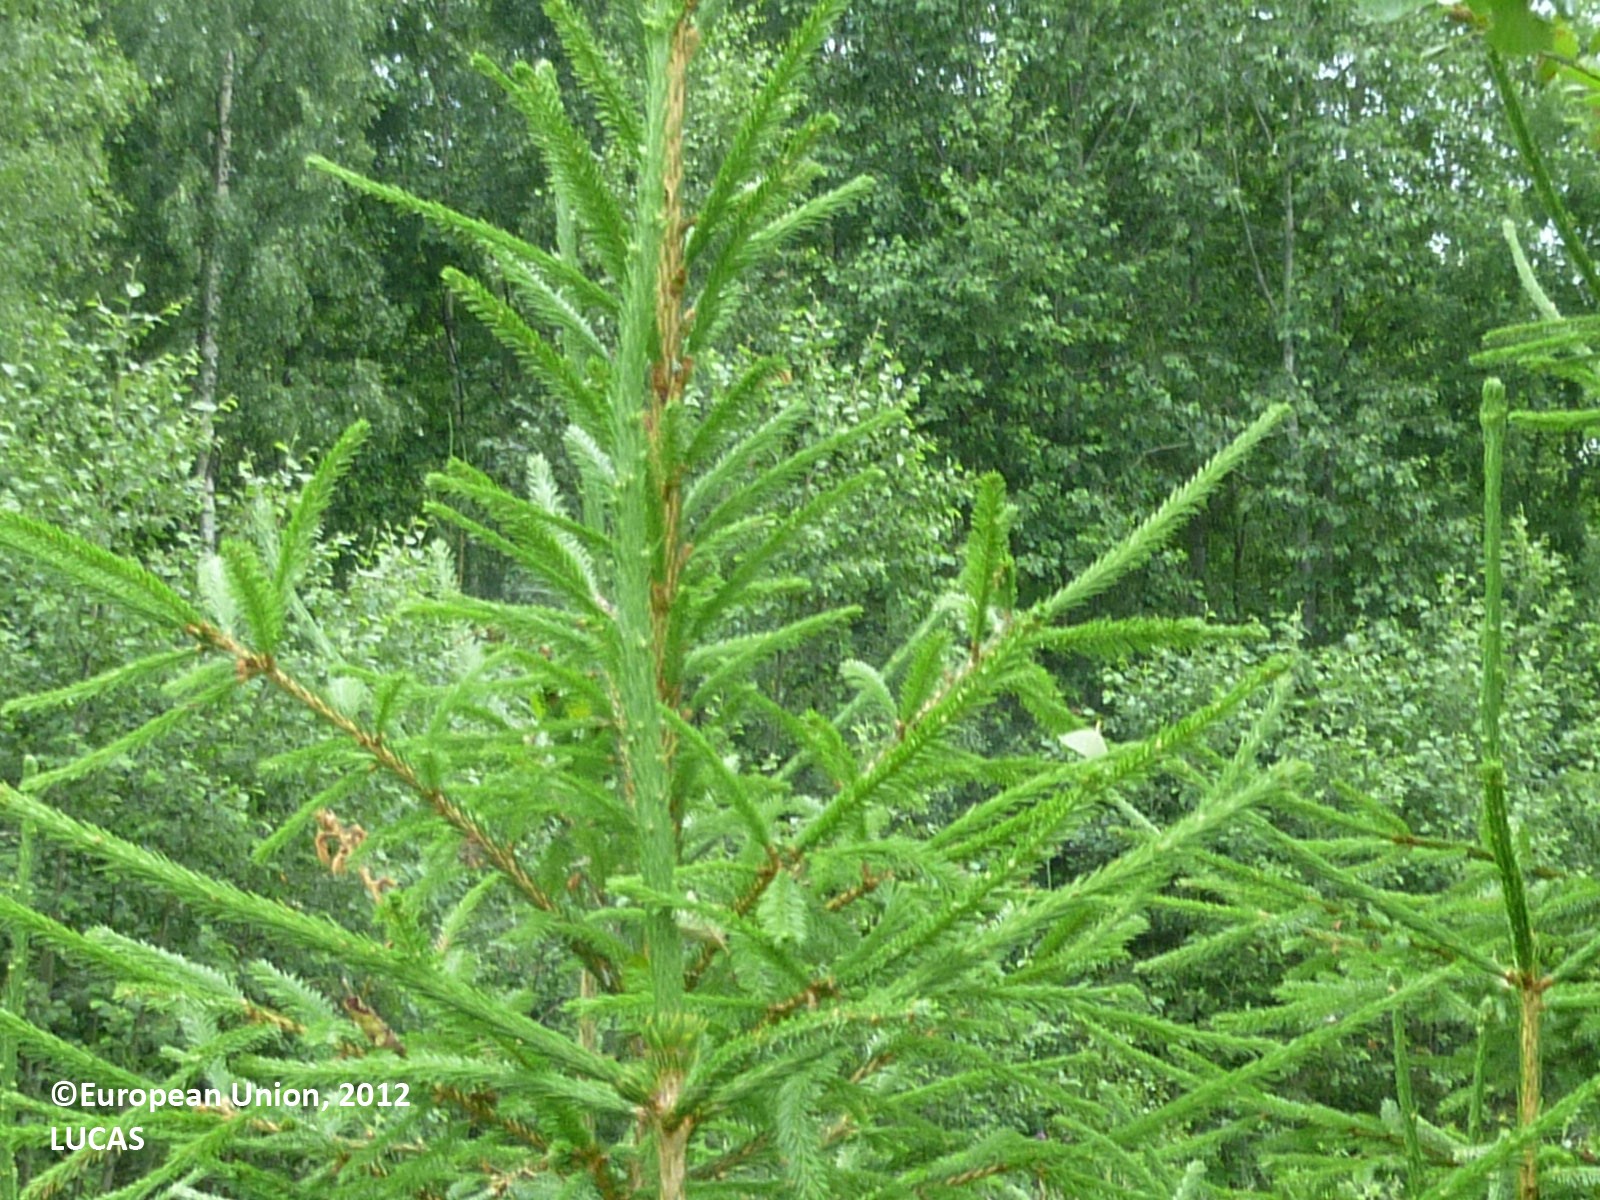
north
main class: Woodland
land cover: Broadleaved woodland
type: boreal forest
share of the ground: > 75 %
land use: Forestry
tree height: > 5 m
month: July
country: FI
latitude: 61.4741
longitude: 22.2044
